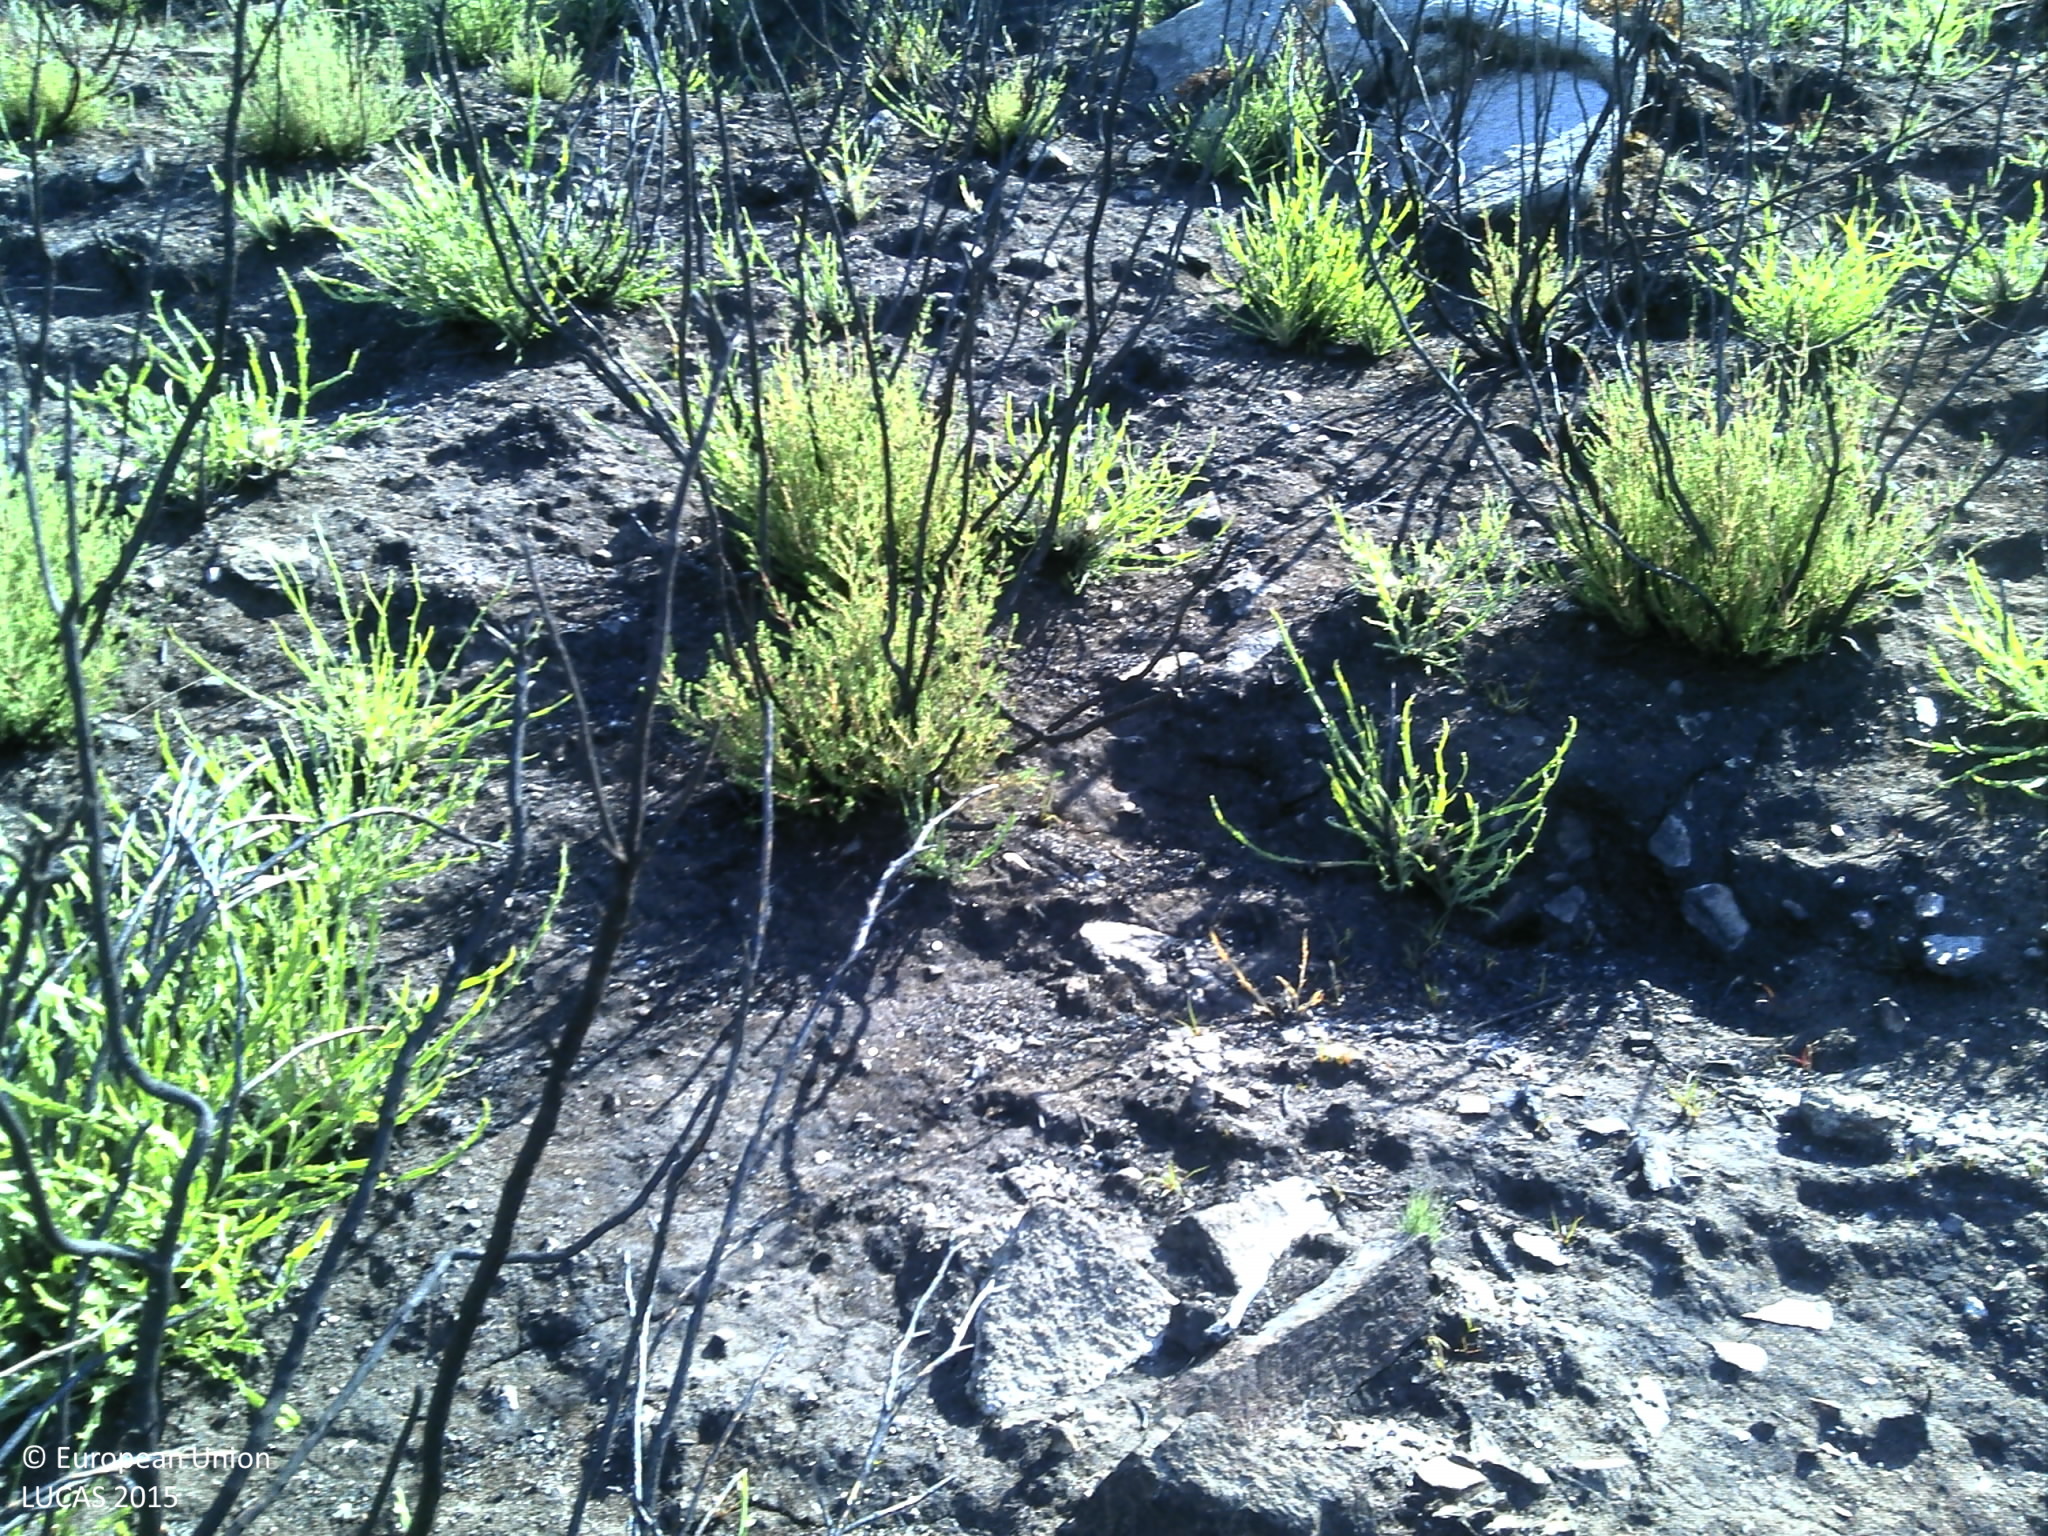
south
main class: Shrubland
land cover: Shrubland without tree cover
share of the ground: 25 - 50 %
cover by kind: unconsolidated bare surface 60 %, shrubs 30 %, herbaceous plants 5 %, consolidated bare surface 5 %
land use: Semi-natural and natural areas not in use
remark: Burnt area
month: July
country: PT
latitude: 41.7563
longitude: -7.6341
